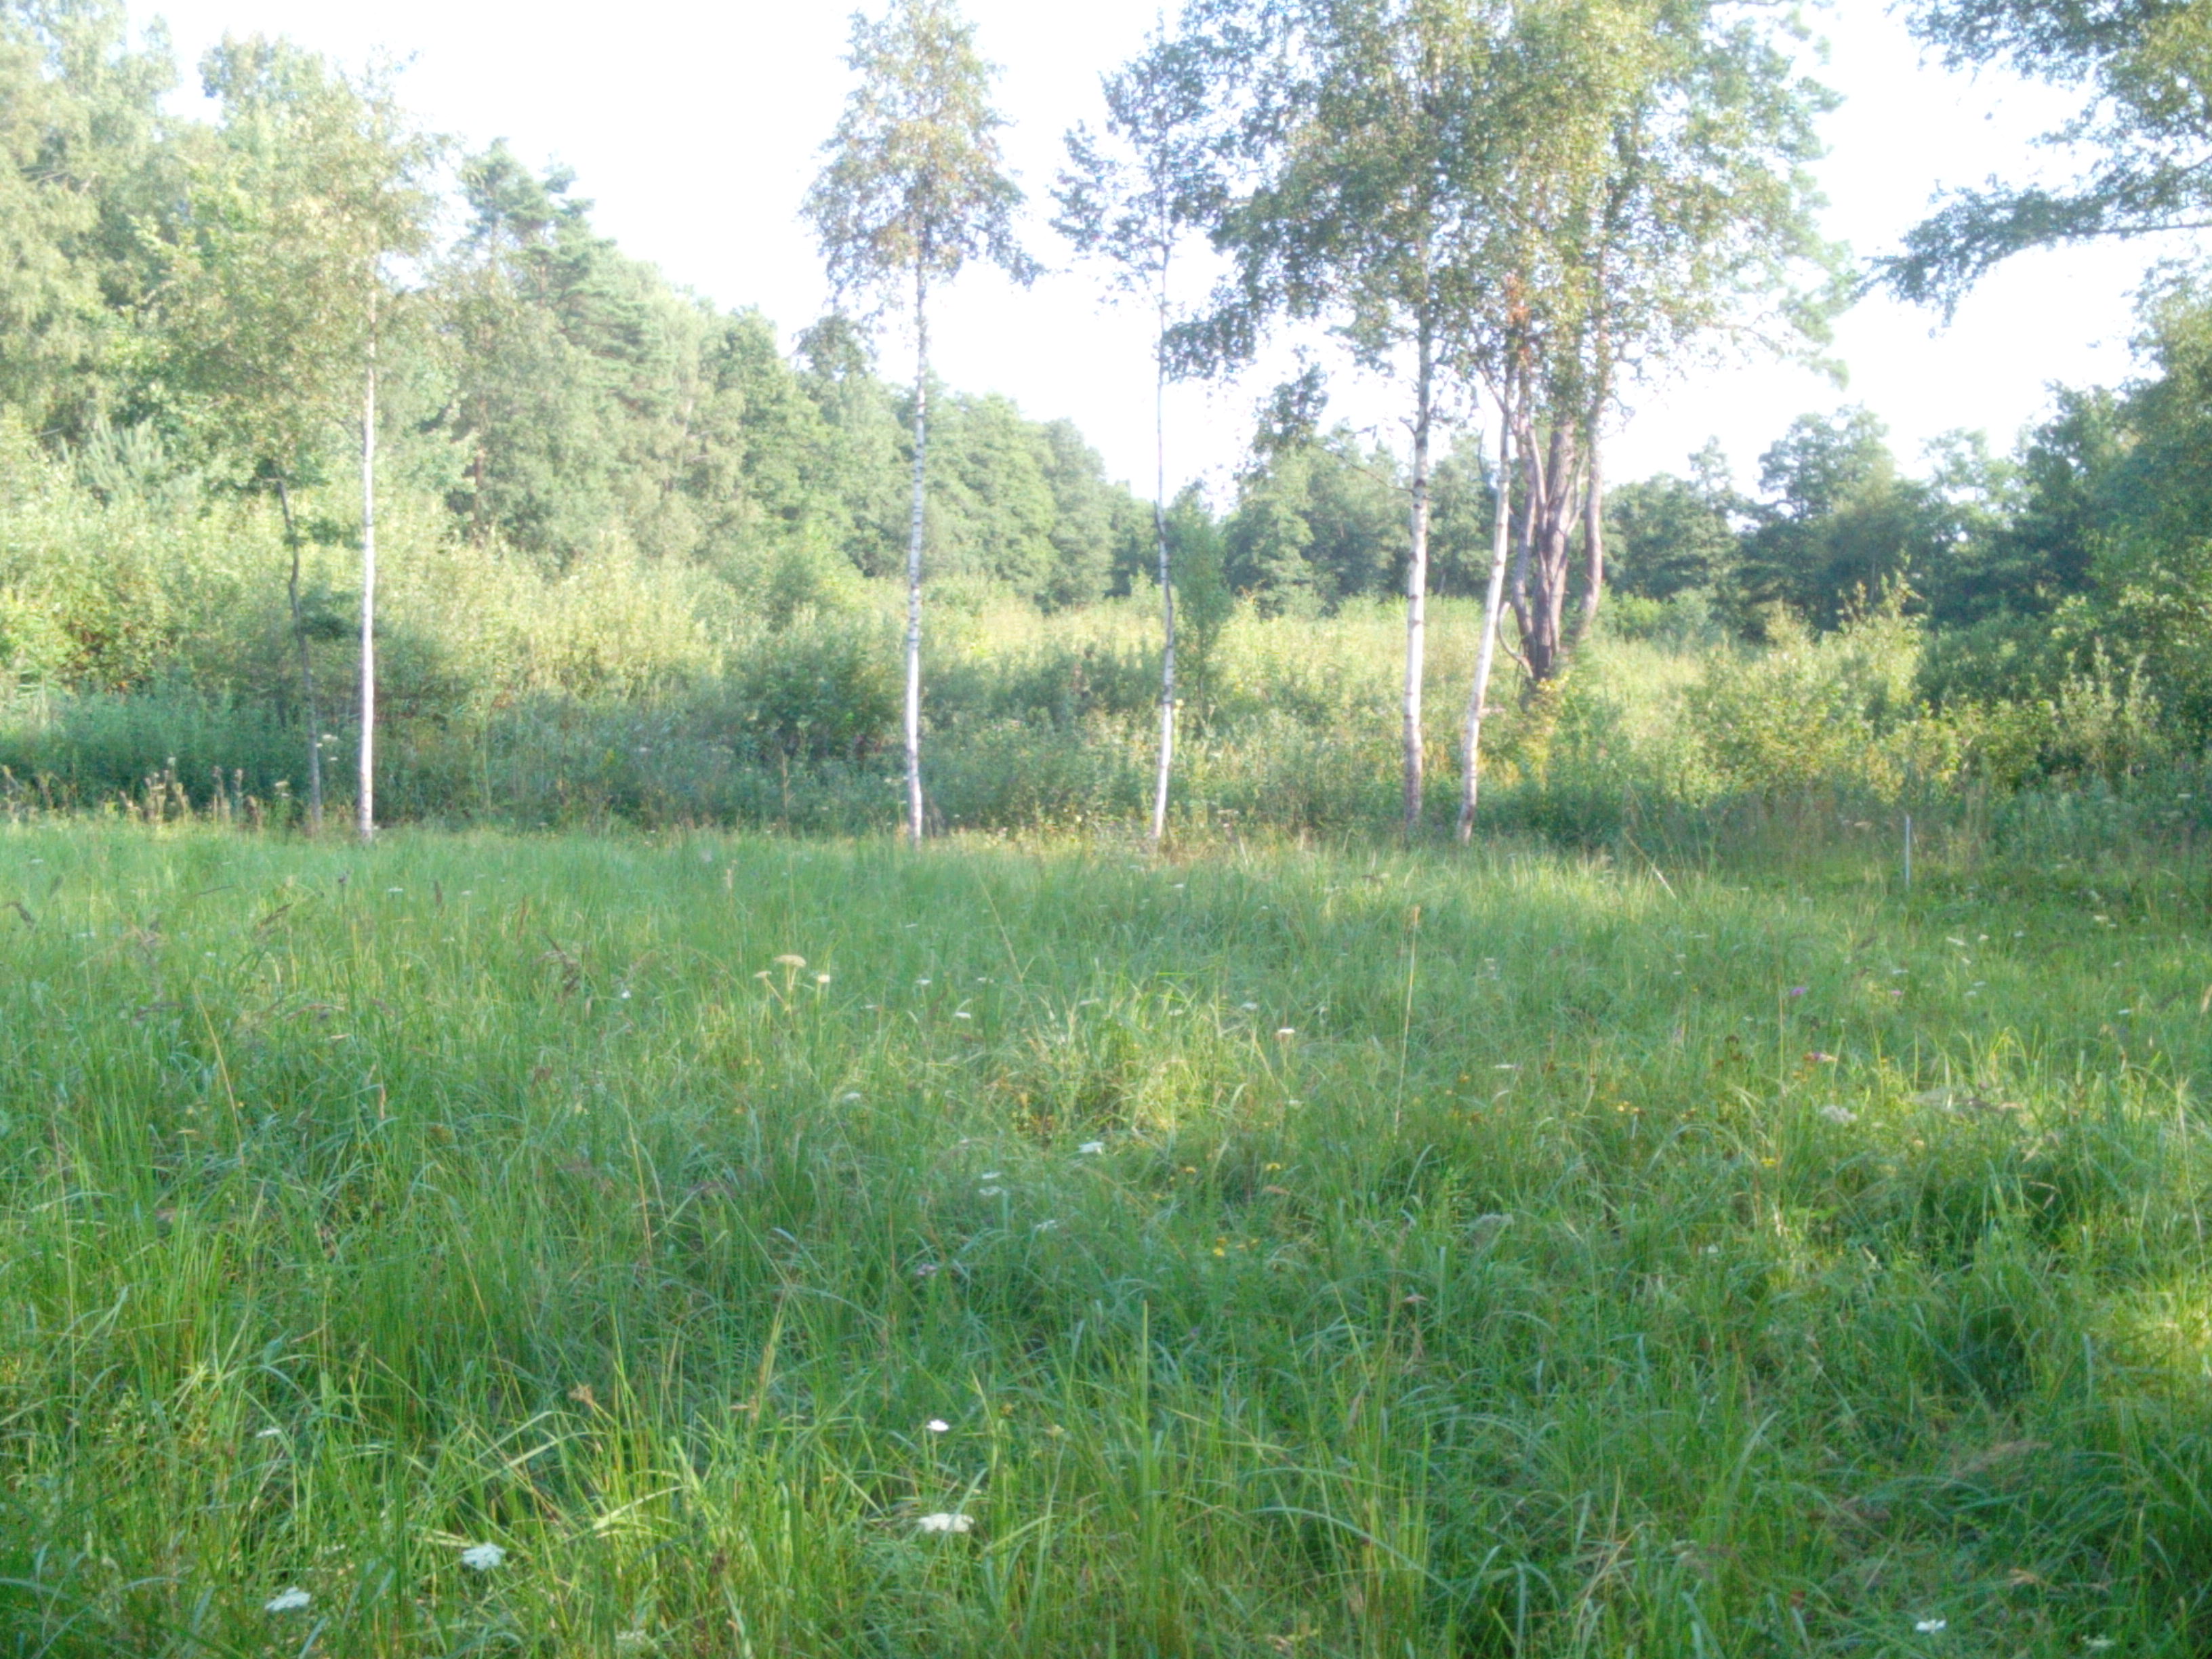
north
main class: Woodland
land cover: Broadleaved woodland
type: non-riverine alder, birch or aspen forest
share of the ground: 25 - 50 %
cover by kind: herbaceous plants 60 %, broadleaved forest trees 40 %
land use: Forestry
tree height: > 5 m
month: August
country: LV
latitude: 56.5776
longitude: 21.0897
